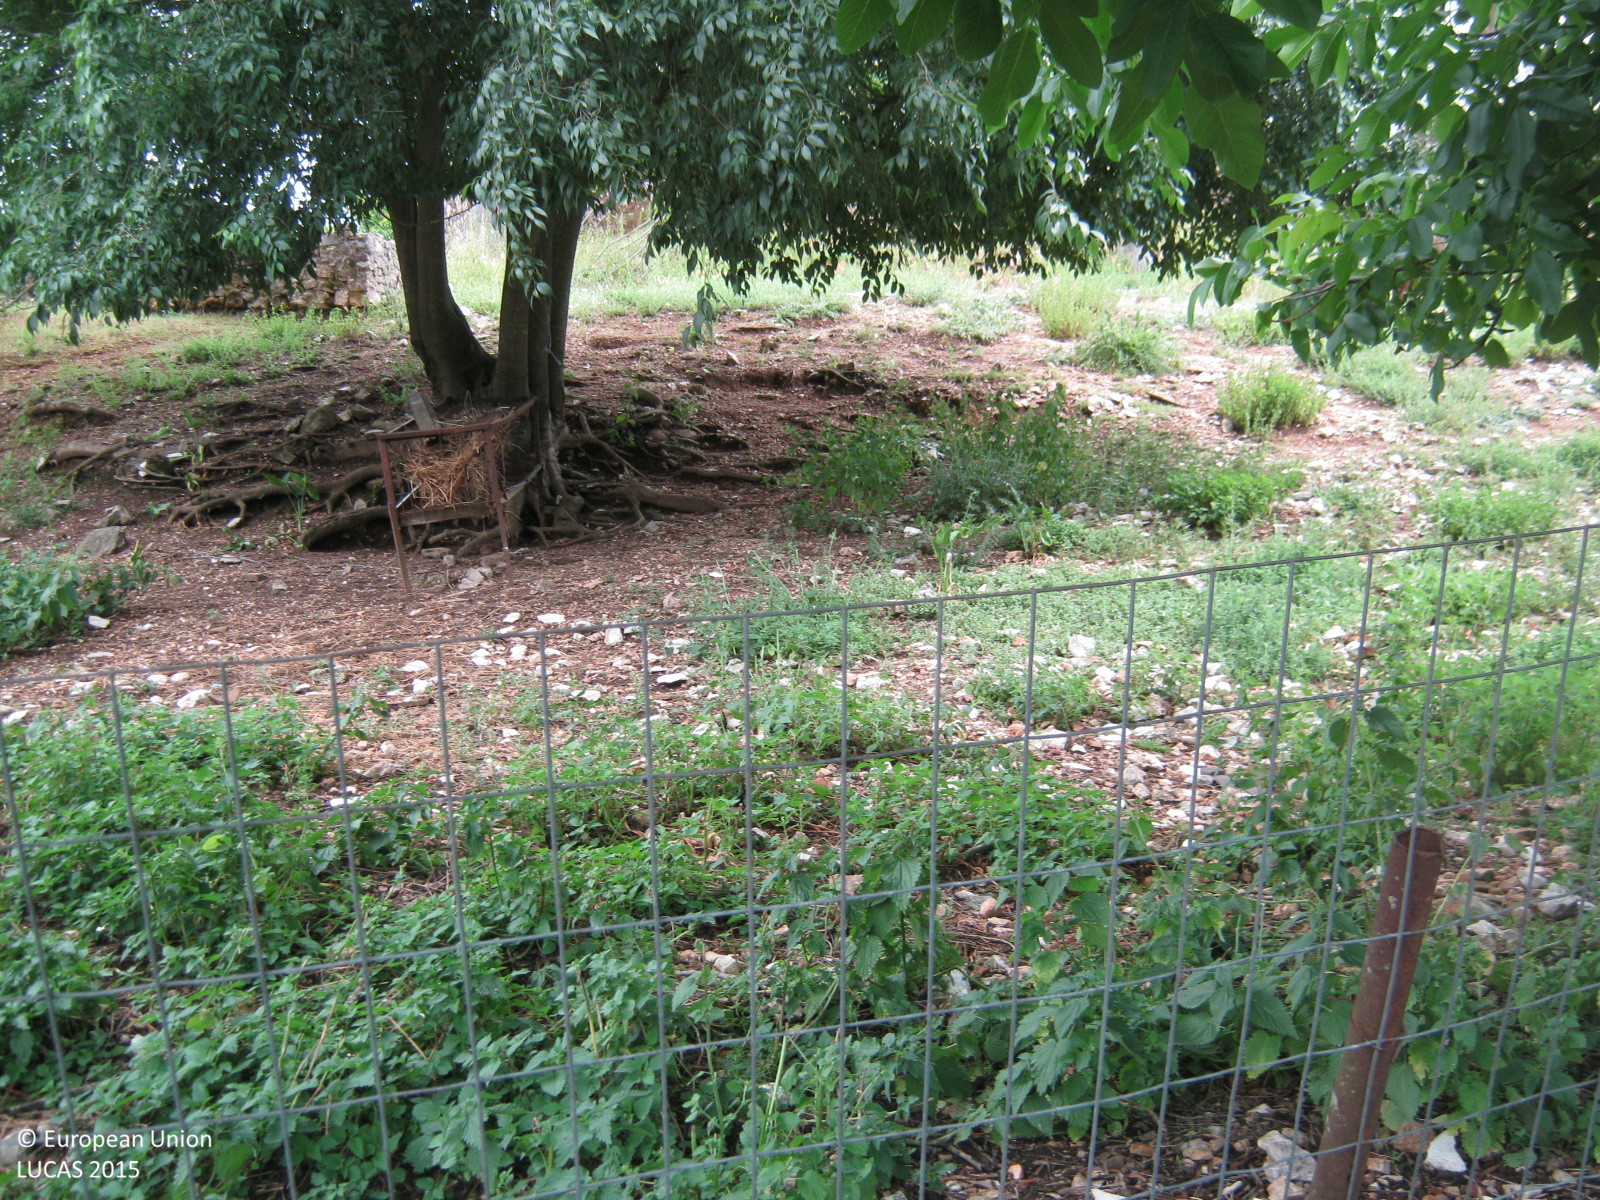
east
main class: Cropland
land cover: Nuts trees
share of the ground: 25 - 50 %
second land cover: Grassland without tree/shrub cover
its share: 25 - 50 %
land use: Agriculture (excluding fallow land and kitchen gardens)
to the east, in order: Nuts trees; Grassland without tree/shrub cover; Artificial constructions in urban areas; Grassland without tree/shrub cover; Artificial constructions; Grassland without tree/shrub cover; Electric lines; Fences; Grass margins; Paved roads, cycling and walking lanes; Artificial constructions in urban areas; Grassland without tree/shrub cover; Fences; Abandoned hedges; Spontaneously vegetated surfaces
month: May
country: GR
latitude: 39.3942
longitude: 20.4820
